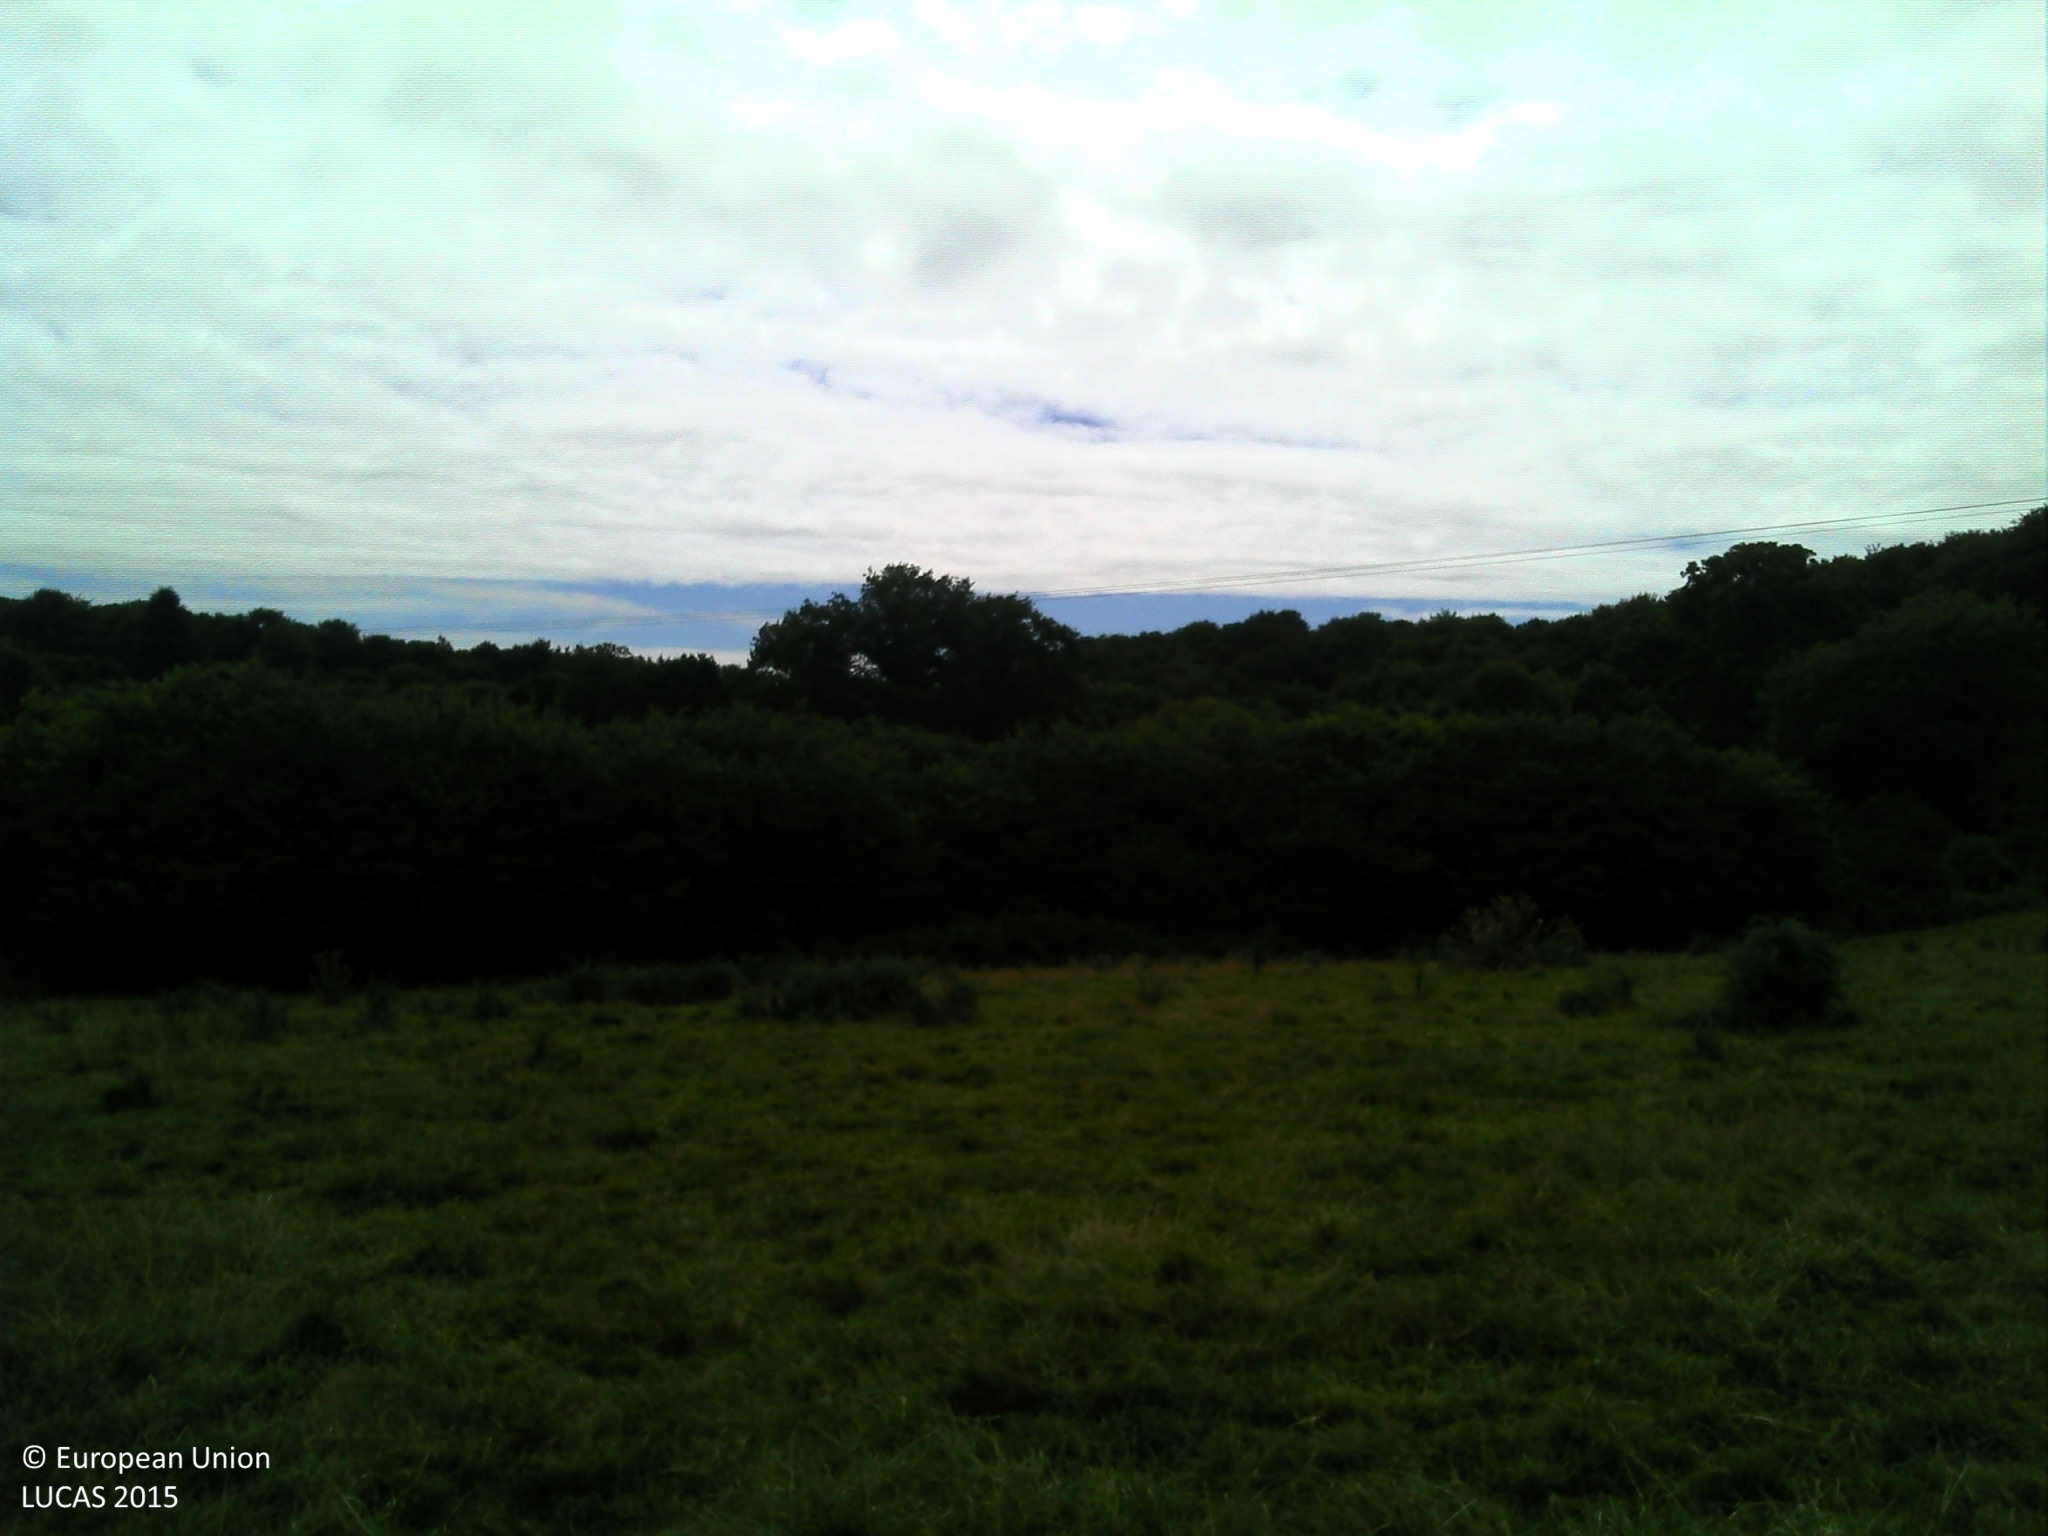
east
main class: Grassland
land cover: Grassland without tree/shrub cover
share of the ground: > 75 %
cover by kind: herbaceous plants 100 %
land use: Agriculture (excluding fallow land and kitchen gardens)
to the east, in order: Grassland without tree/shrub cover; Fences; Broadleaved woodland; Rivers and streams; Broadleaved woodland; Fences; Grassland without tree/shrub cover; Electric lines; Grassland without tree/shrub cover; Fences; Spontaneously vegetated surfaces; Ditches and canals; Lines of trees; Fences; Grassland without tree/shrub cover; Fences; Lines of trees; Grassland without tree/shrub cover
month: August
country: FR
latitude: 48.4944
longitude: -3.4064
